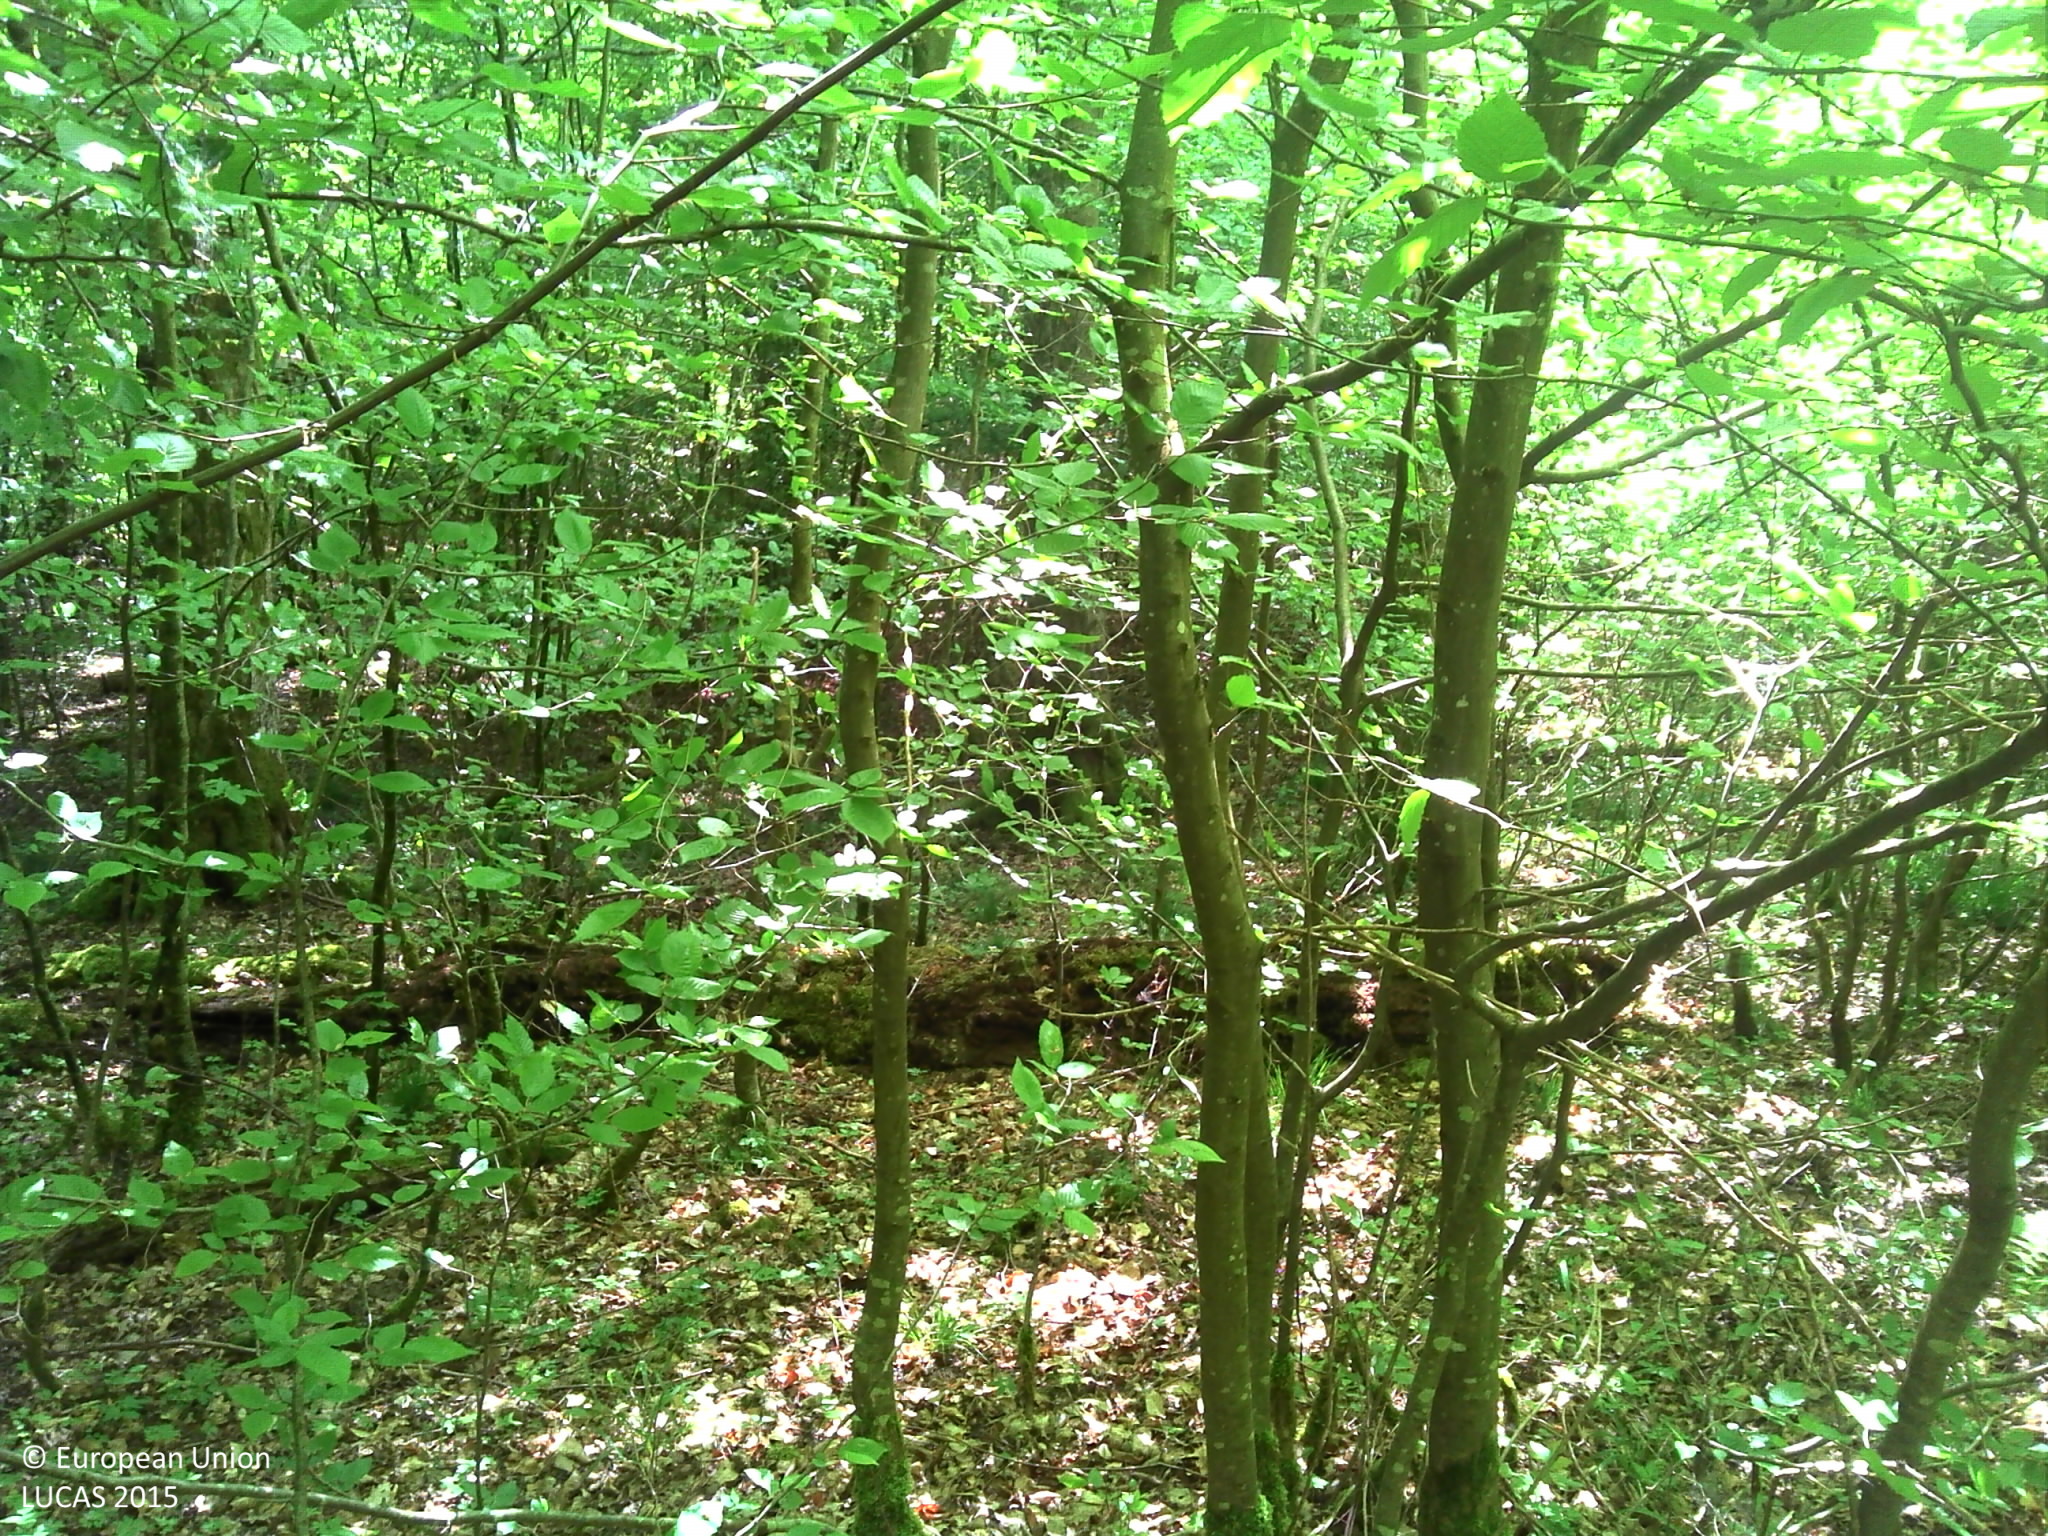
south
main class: Woodland
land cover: Broadleaved woodland
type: acidophilous oak and oak-birch forest
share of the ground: > 75 %
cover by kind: broadleaved forest trees 80 %, herbaceous plants 10 %, lichens and mosses 10 %
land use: Forestry
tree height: > 5 m
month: May
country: LU
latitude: 49.6912
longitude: 6.2706
